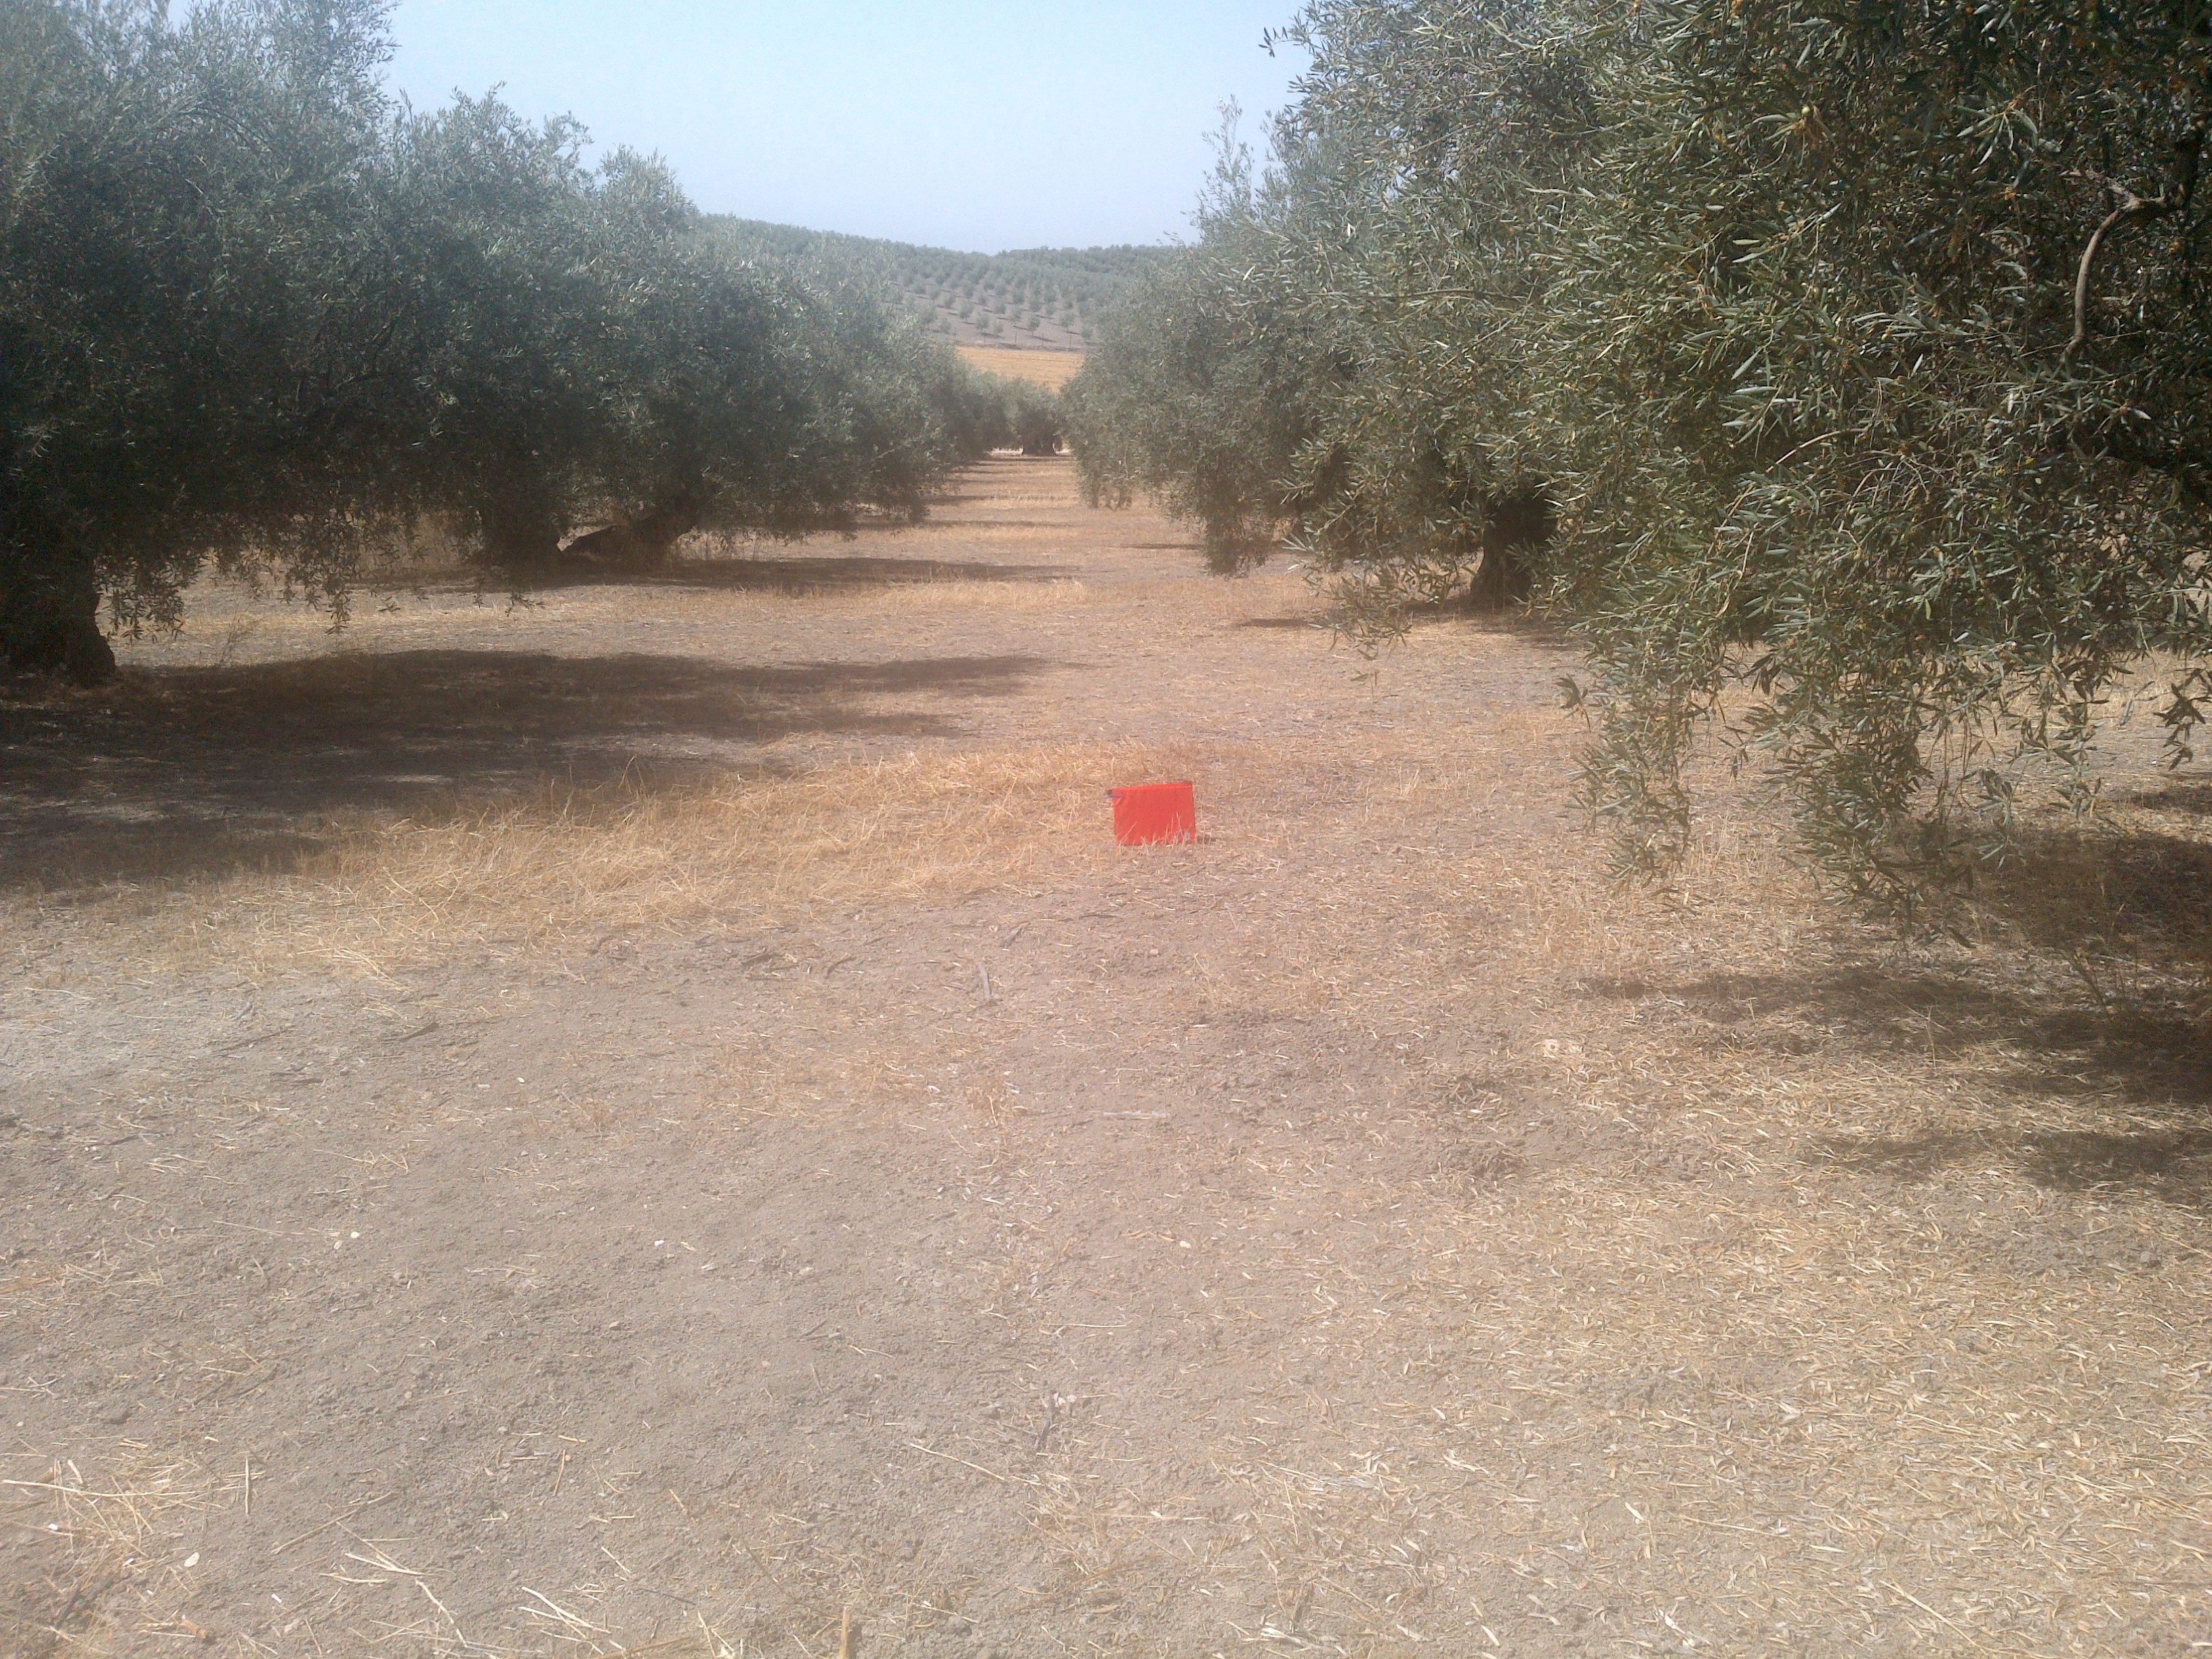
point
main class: Cropland
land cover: Olive groves
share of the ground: 50 - 75 %
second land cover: Spontaneously vegetated surfaces
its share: 10 - 25 %
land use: Agriculture (excluding fallow land and kitchen gardens)
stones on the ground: < 10 %
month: July
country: ES
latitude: 37.4280
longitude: -4.5705
